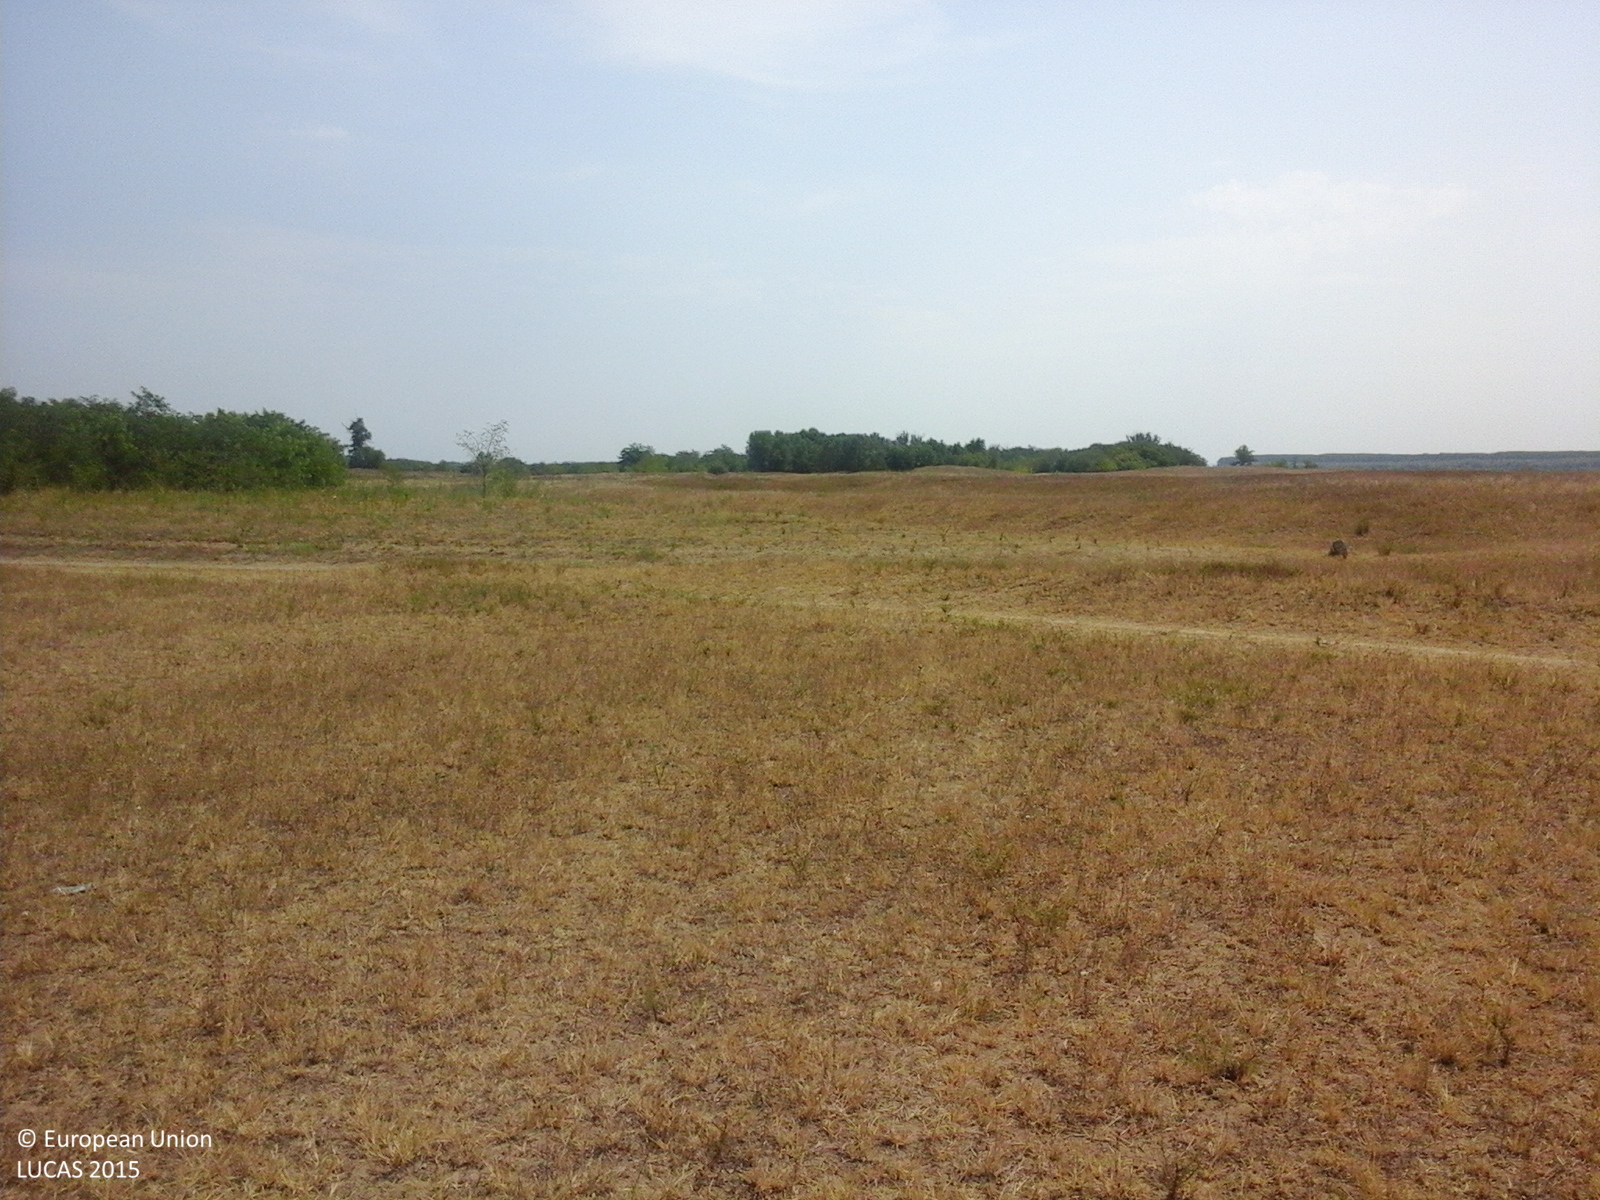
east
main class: Grassland
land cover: Grassland without tree/shrub cover
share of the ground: > 75 %
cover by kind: herbaceous plants 100 %
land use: Agriculture (excluding fallow land and kitchen gardens)
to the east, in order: Grassland without tree/shrub cover; Tracks; Grassland without tree/shrub cover; Tracks; Spontaneously vegetated surfaces
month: August
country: RO
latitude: 43.8253
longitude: 23.6659
